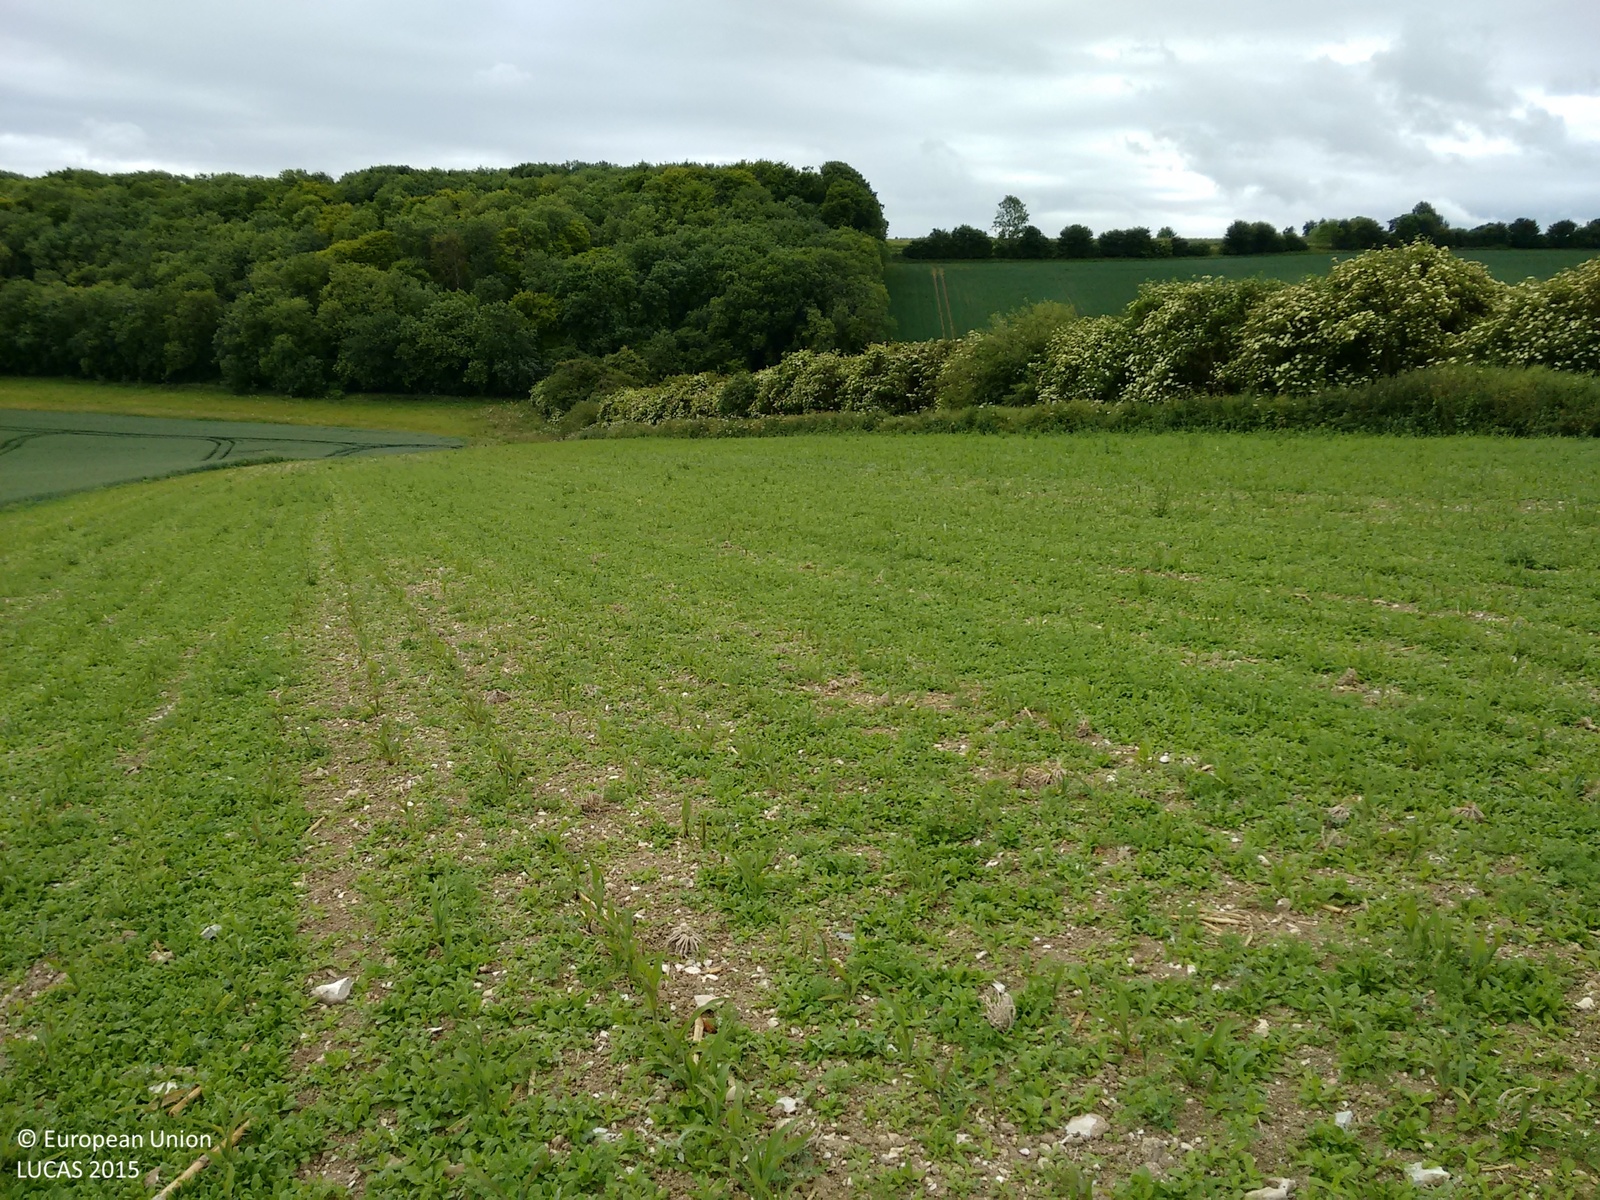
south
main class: Cropland
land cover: Maize
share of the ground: 10 - 25 %
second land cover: Spontaneously vegetated surfaces
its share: > 75 %
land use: Agriculture (excluding fallow land and kitchen gardens)
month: June
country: GB
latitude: 51.5200
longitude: -1.1873
